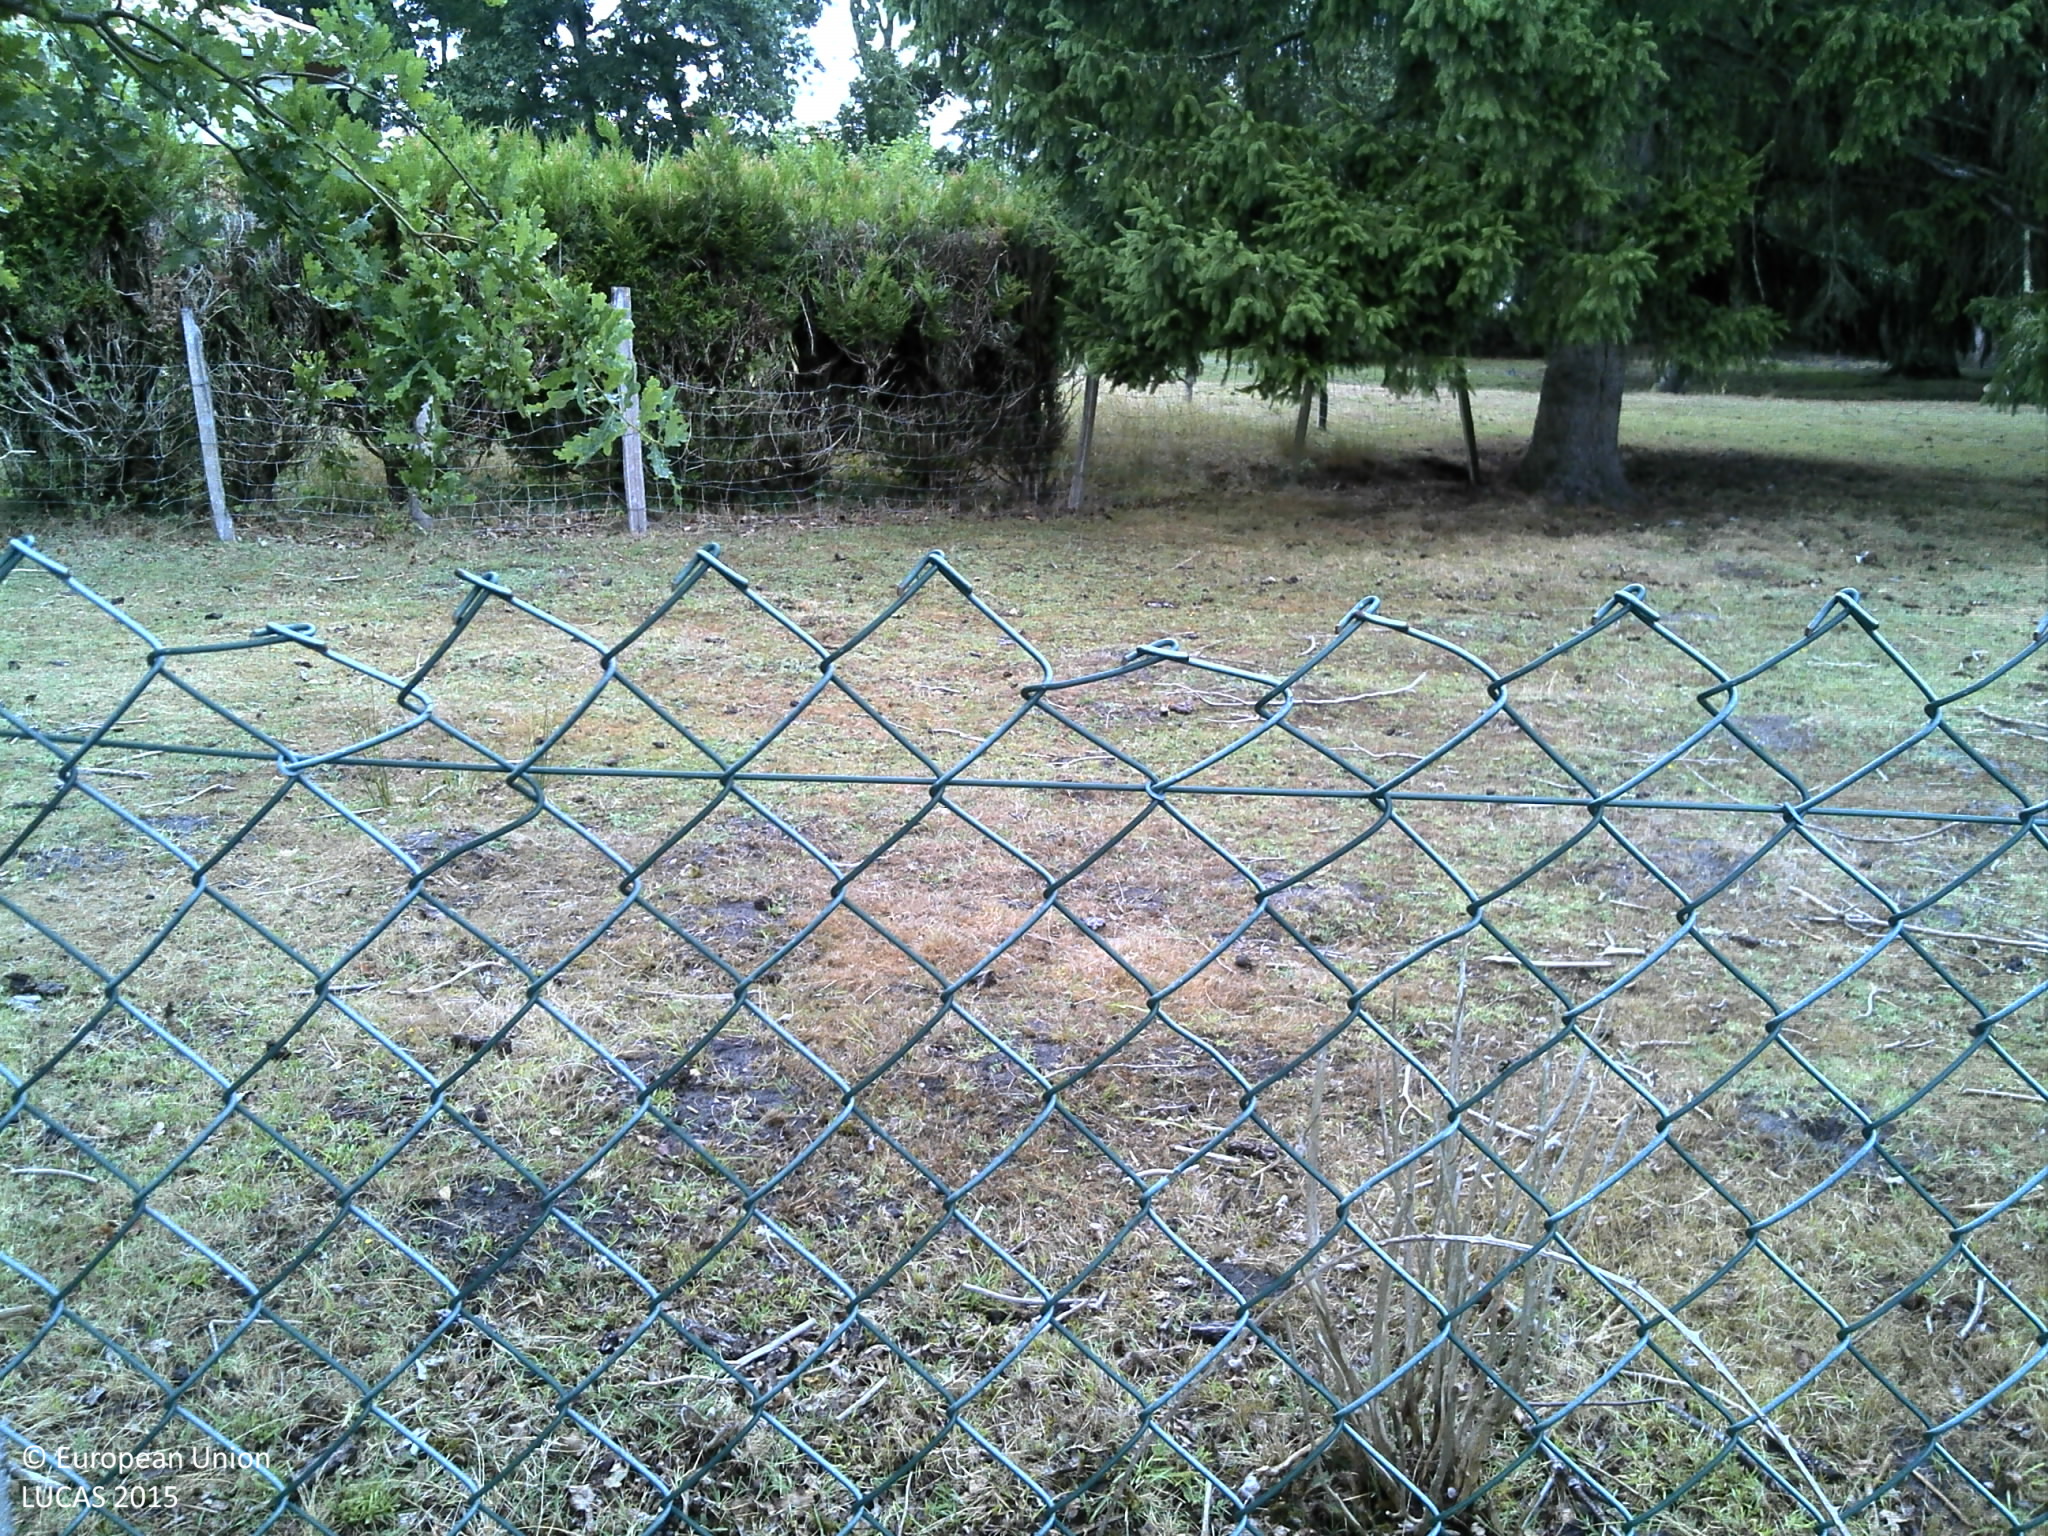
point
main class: Grassland
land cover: Grassland without tree/shrub cover
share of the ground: > 75 %
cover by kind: herbaceous plants 100 %
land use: Residential
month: July
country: FR
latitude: 44.7546
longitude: -0.7442
